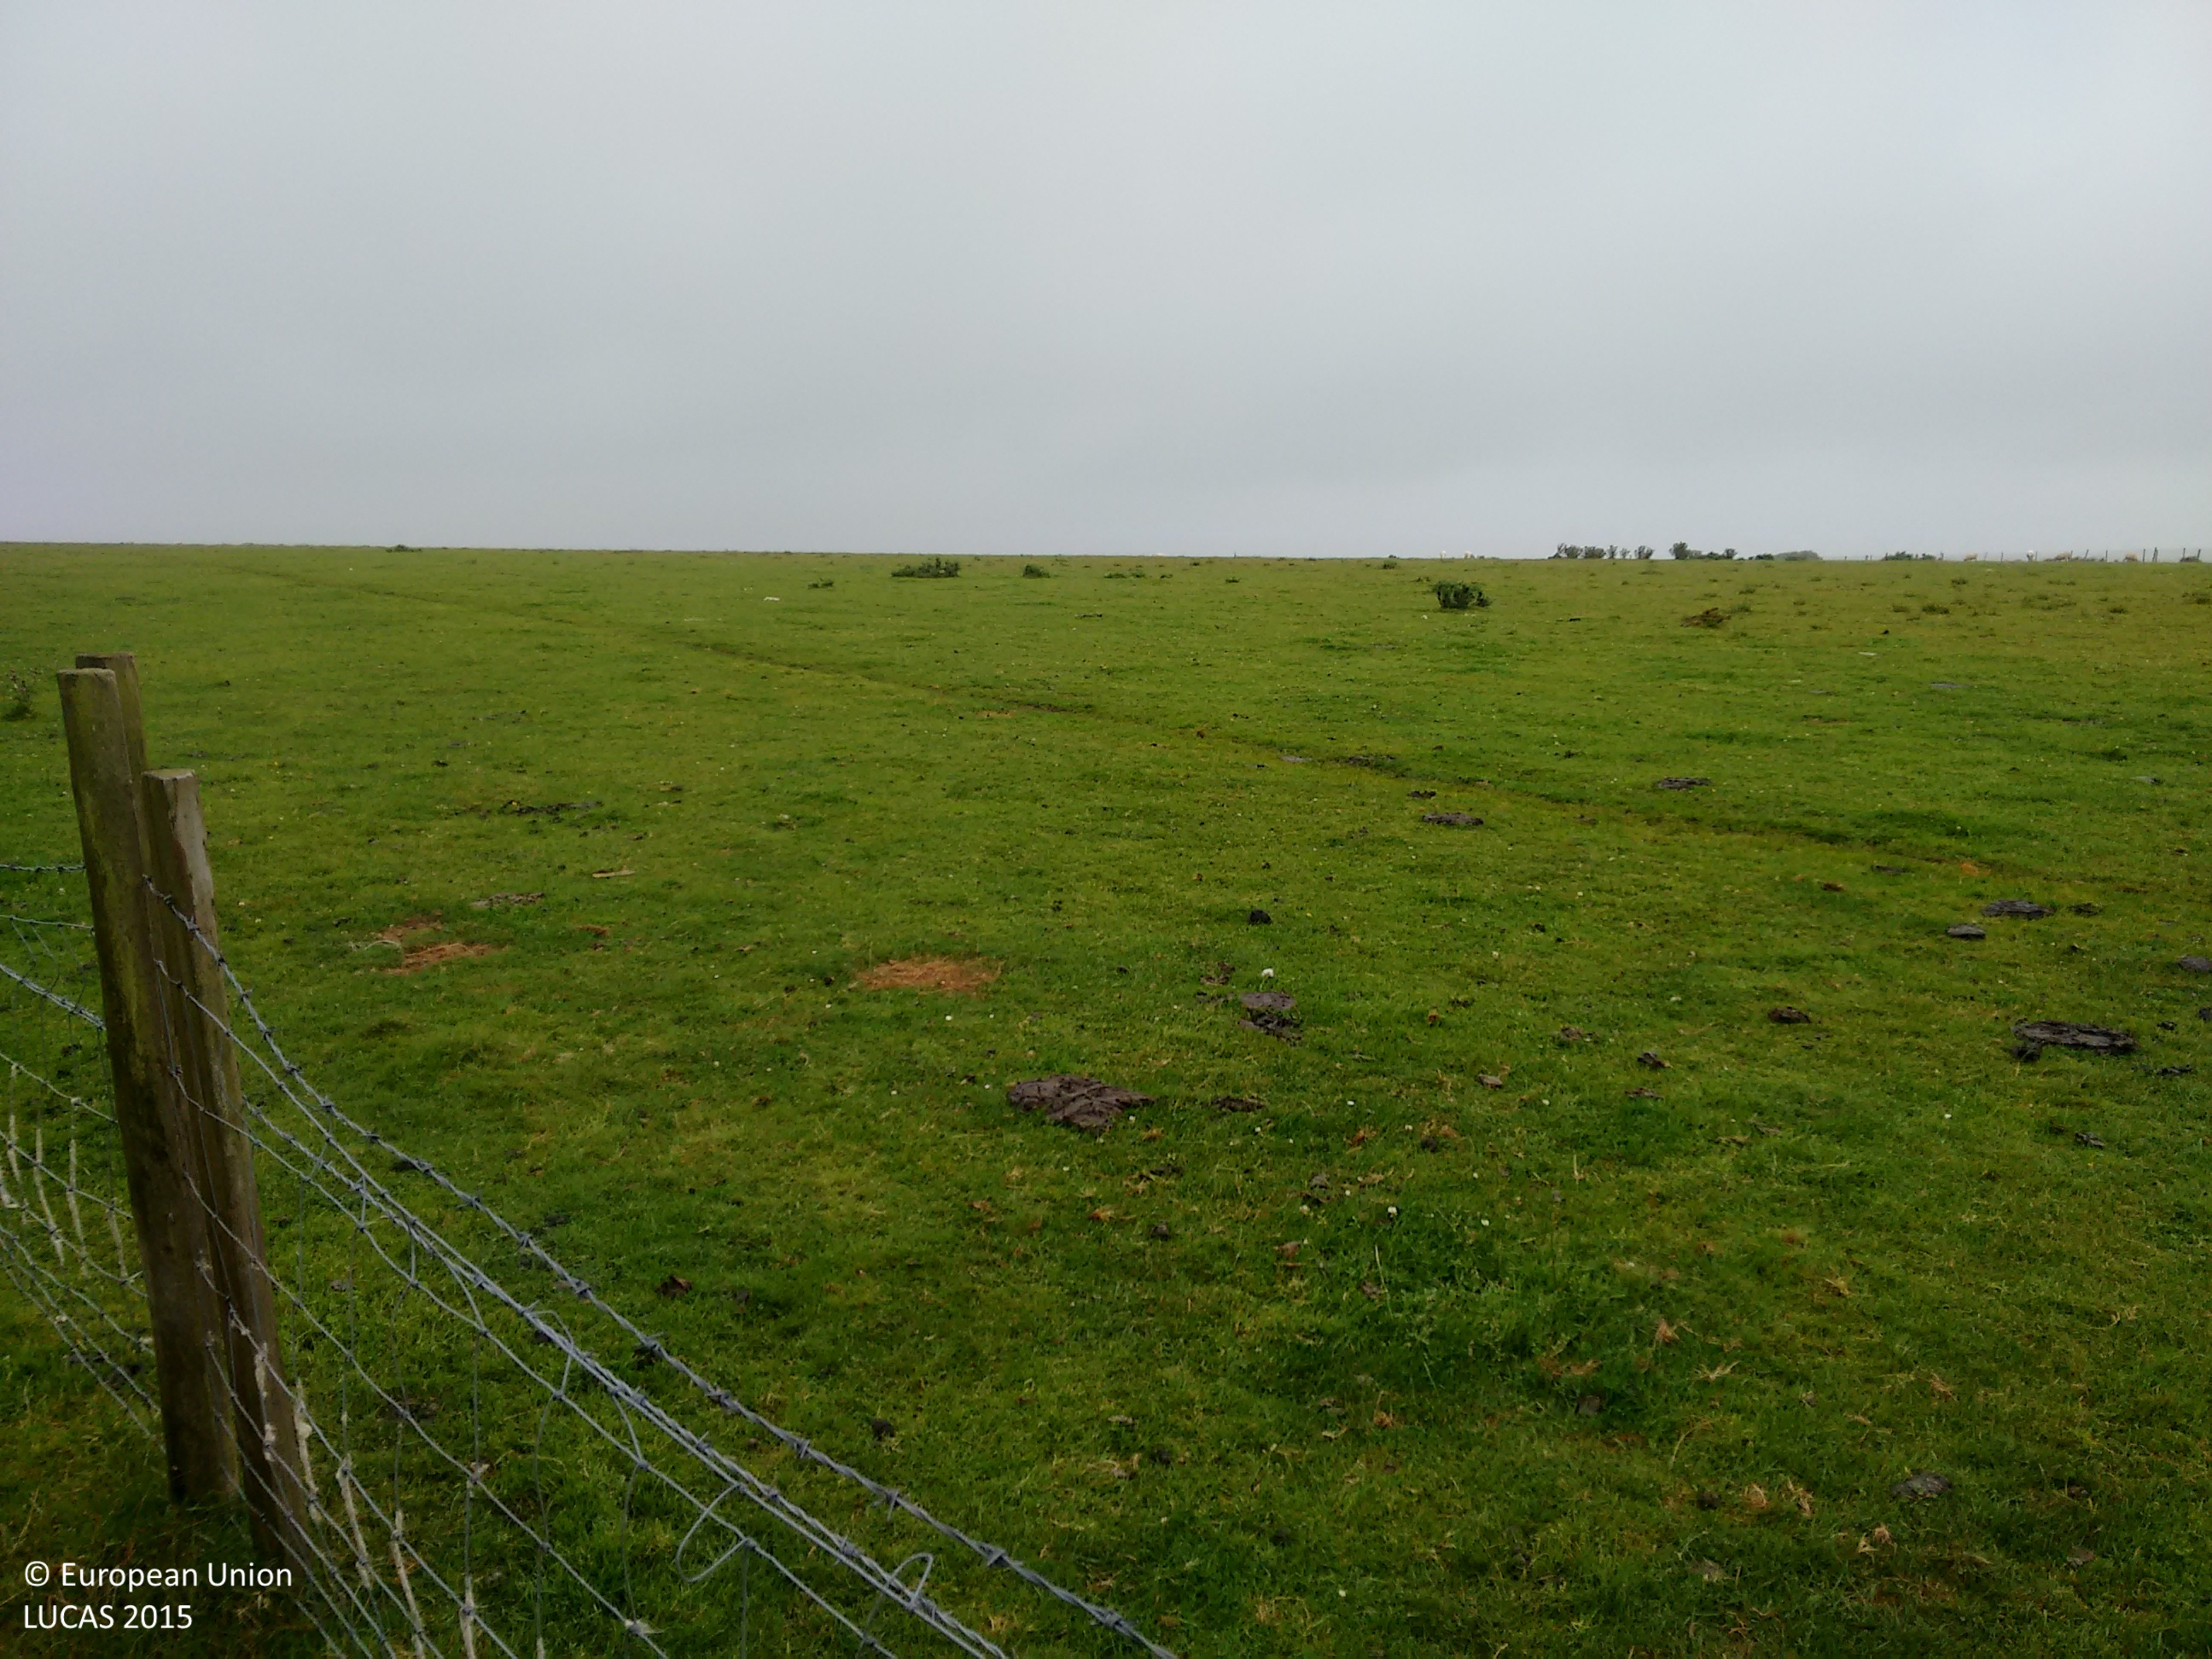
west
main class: Grassland
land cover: Grassland without tree/shrub cover
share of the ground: > 75 %
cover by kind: herbaceous plants 100 %
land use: Agriculture (excluding fallow land and kitchen gardens)
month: August
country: GB
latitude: 51.9528
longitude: -4.5256
